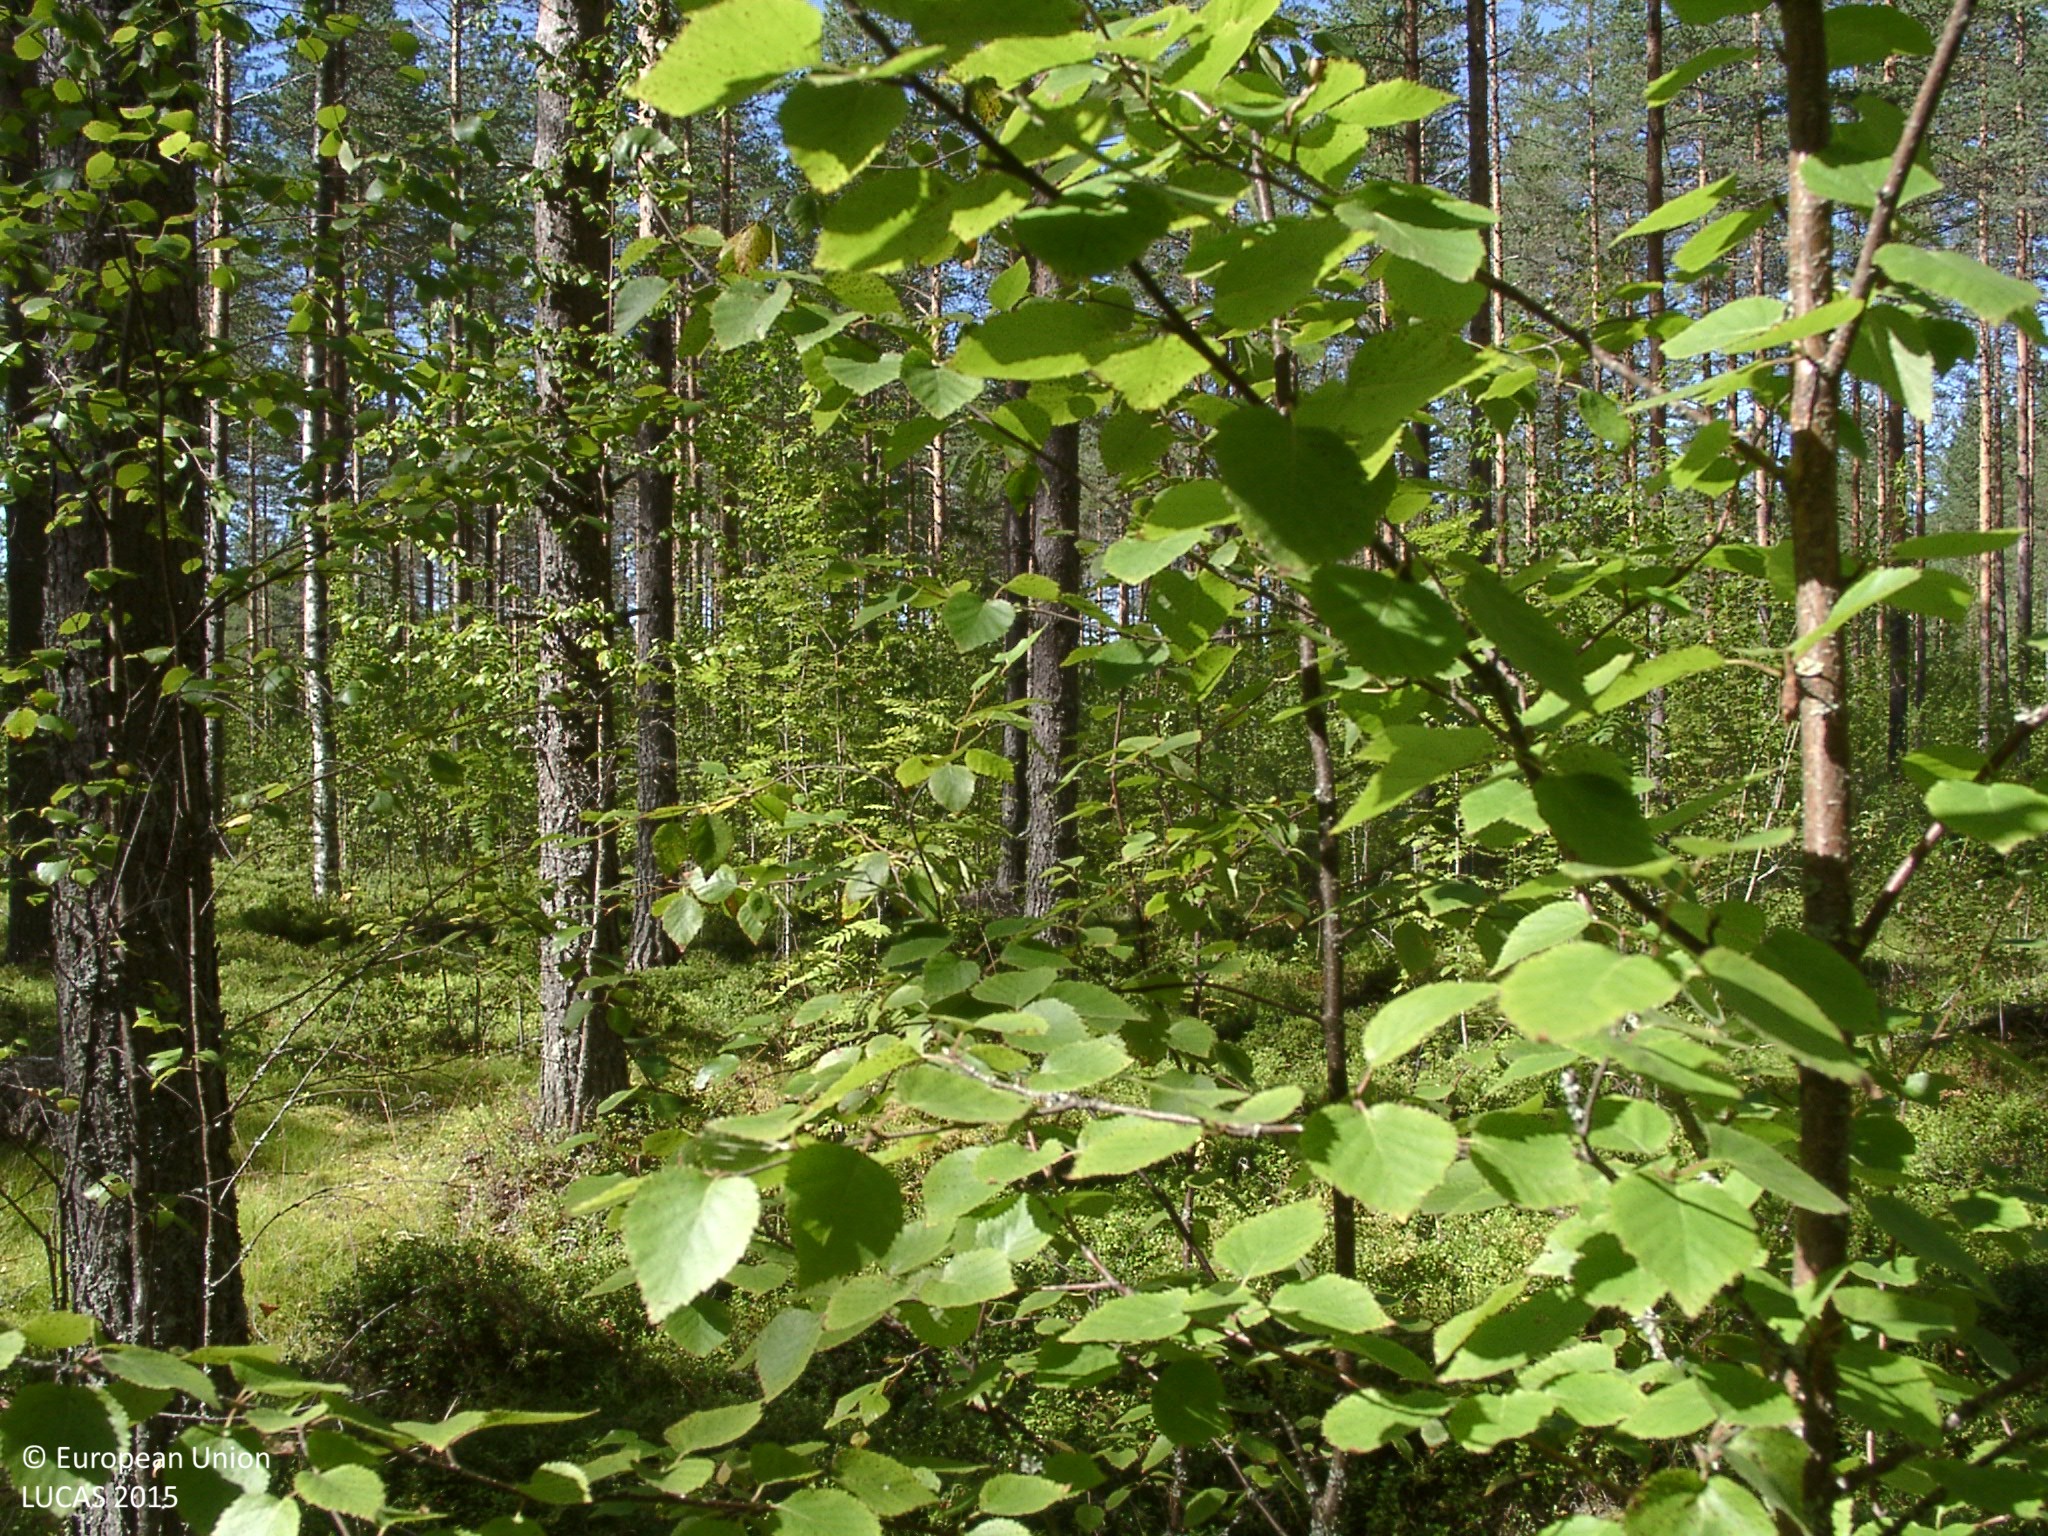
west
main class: Woodland
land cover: Pine dominated coniferous woodland
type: boreal forest
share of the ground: 50 - 75 %
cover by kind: coniferous forest trees 55 %, shrubs 20 %, broadleaved forest trees 15 %, lichens and mosses 10 %
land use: Forestry
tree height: > 5 m
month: August
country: FI
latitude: 62.3606
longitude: 25.2760
